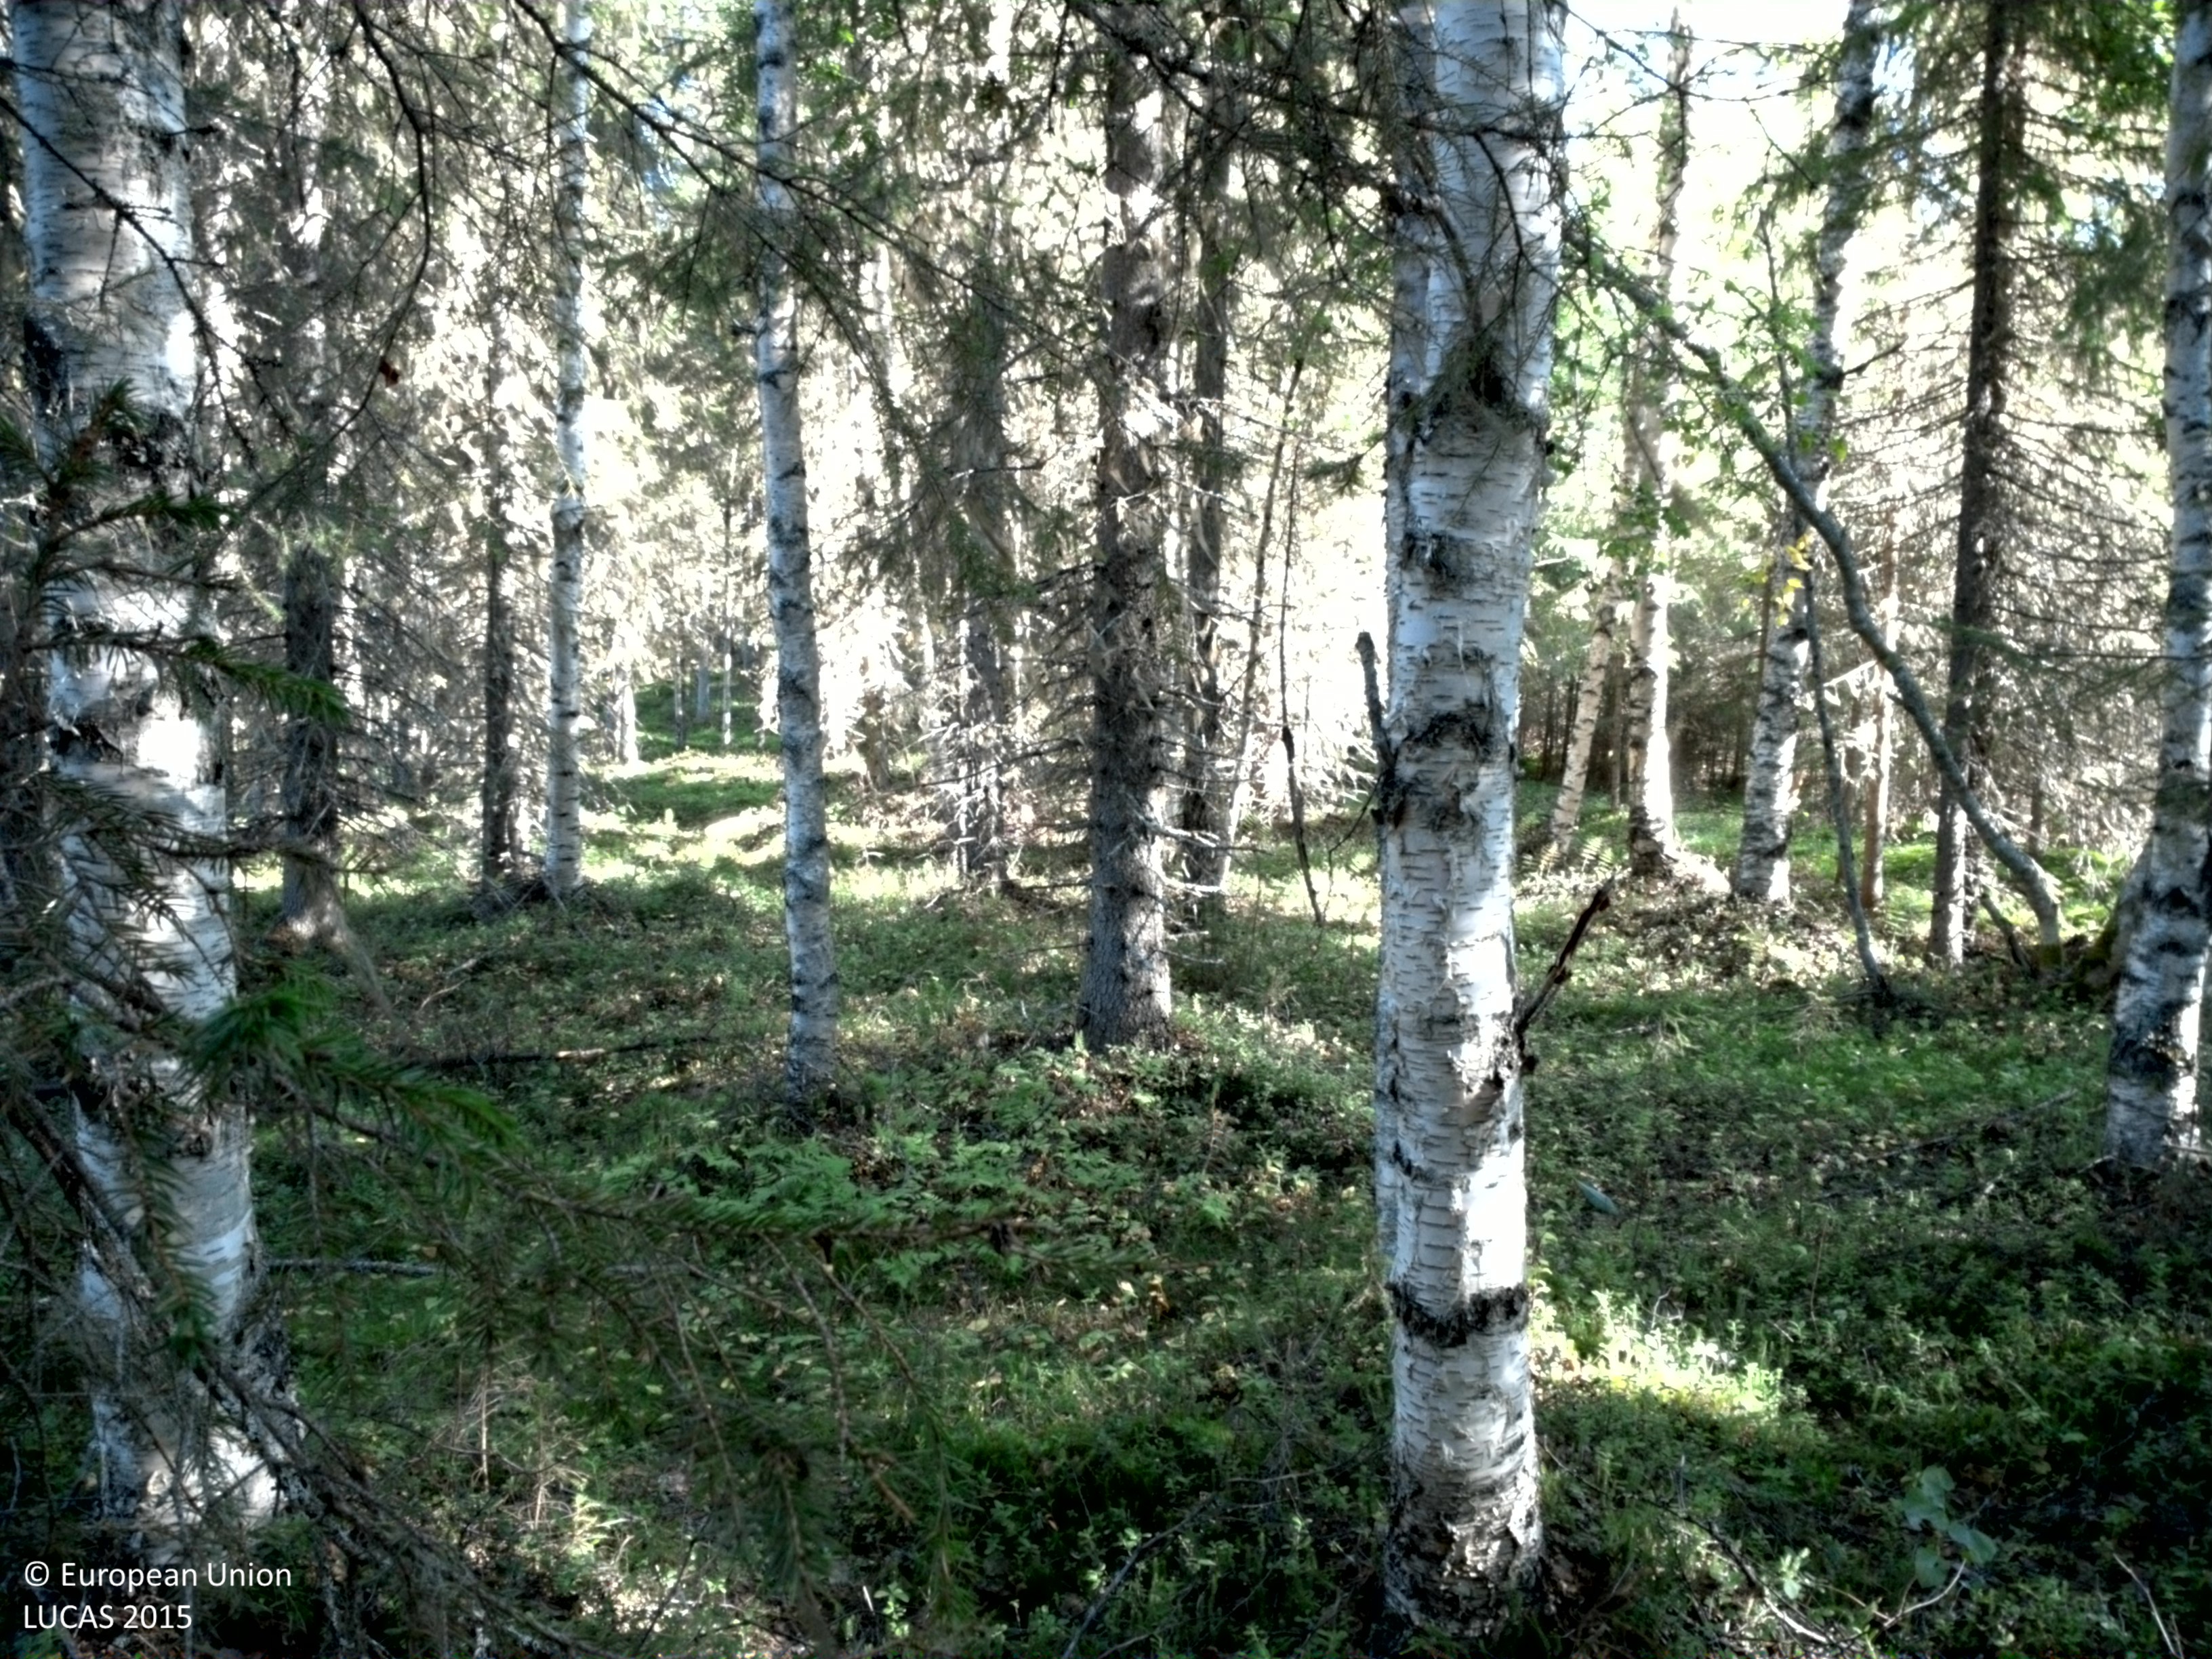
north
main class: Woodland
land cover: Spruce dominated coniferous woodland
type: boreal forest
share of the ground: 50 - 75 %
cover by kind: coniferous forest trees 50 %, shrubs 45 %, broadleaved forest trees 5 %
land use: Forestry
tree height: > 5 m
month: August
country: SE
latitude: 66.1280
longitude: 22.6672
